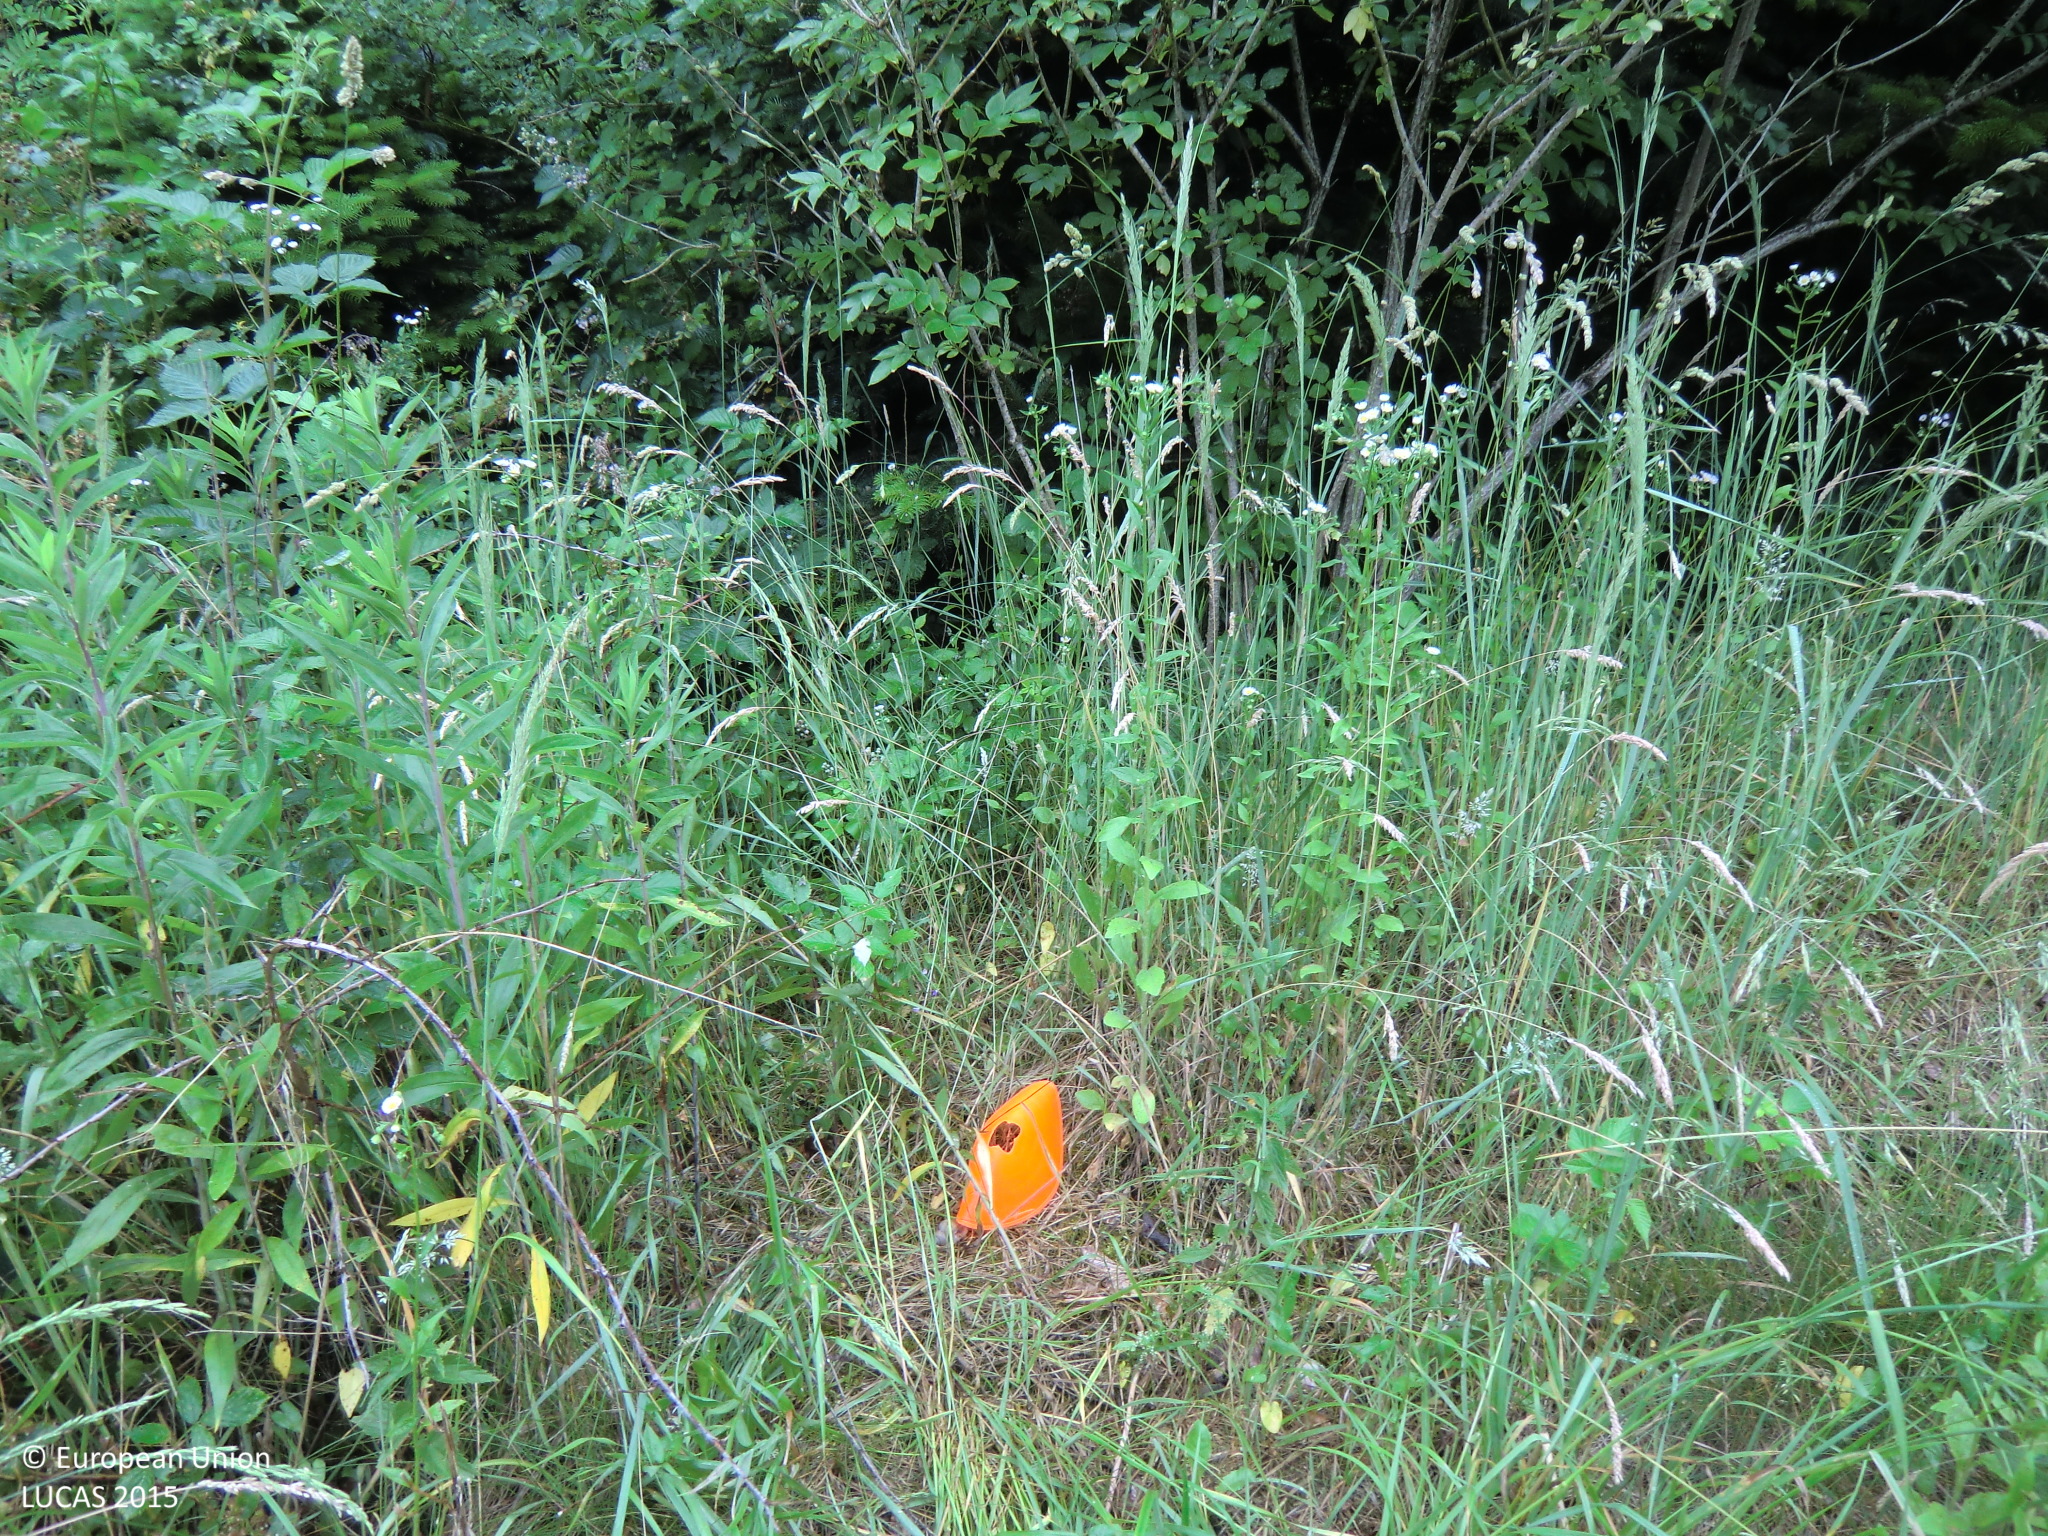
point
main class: Grassland
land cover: Grassland without tree/shrub cover
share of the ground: > 75 %
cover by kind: herbaceous plants 100 %
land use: Agriculture (excluding fallow land and kitchen gardens)
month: June
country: AT
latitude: 47.1935
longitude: 16.0069
